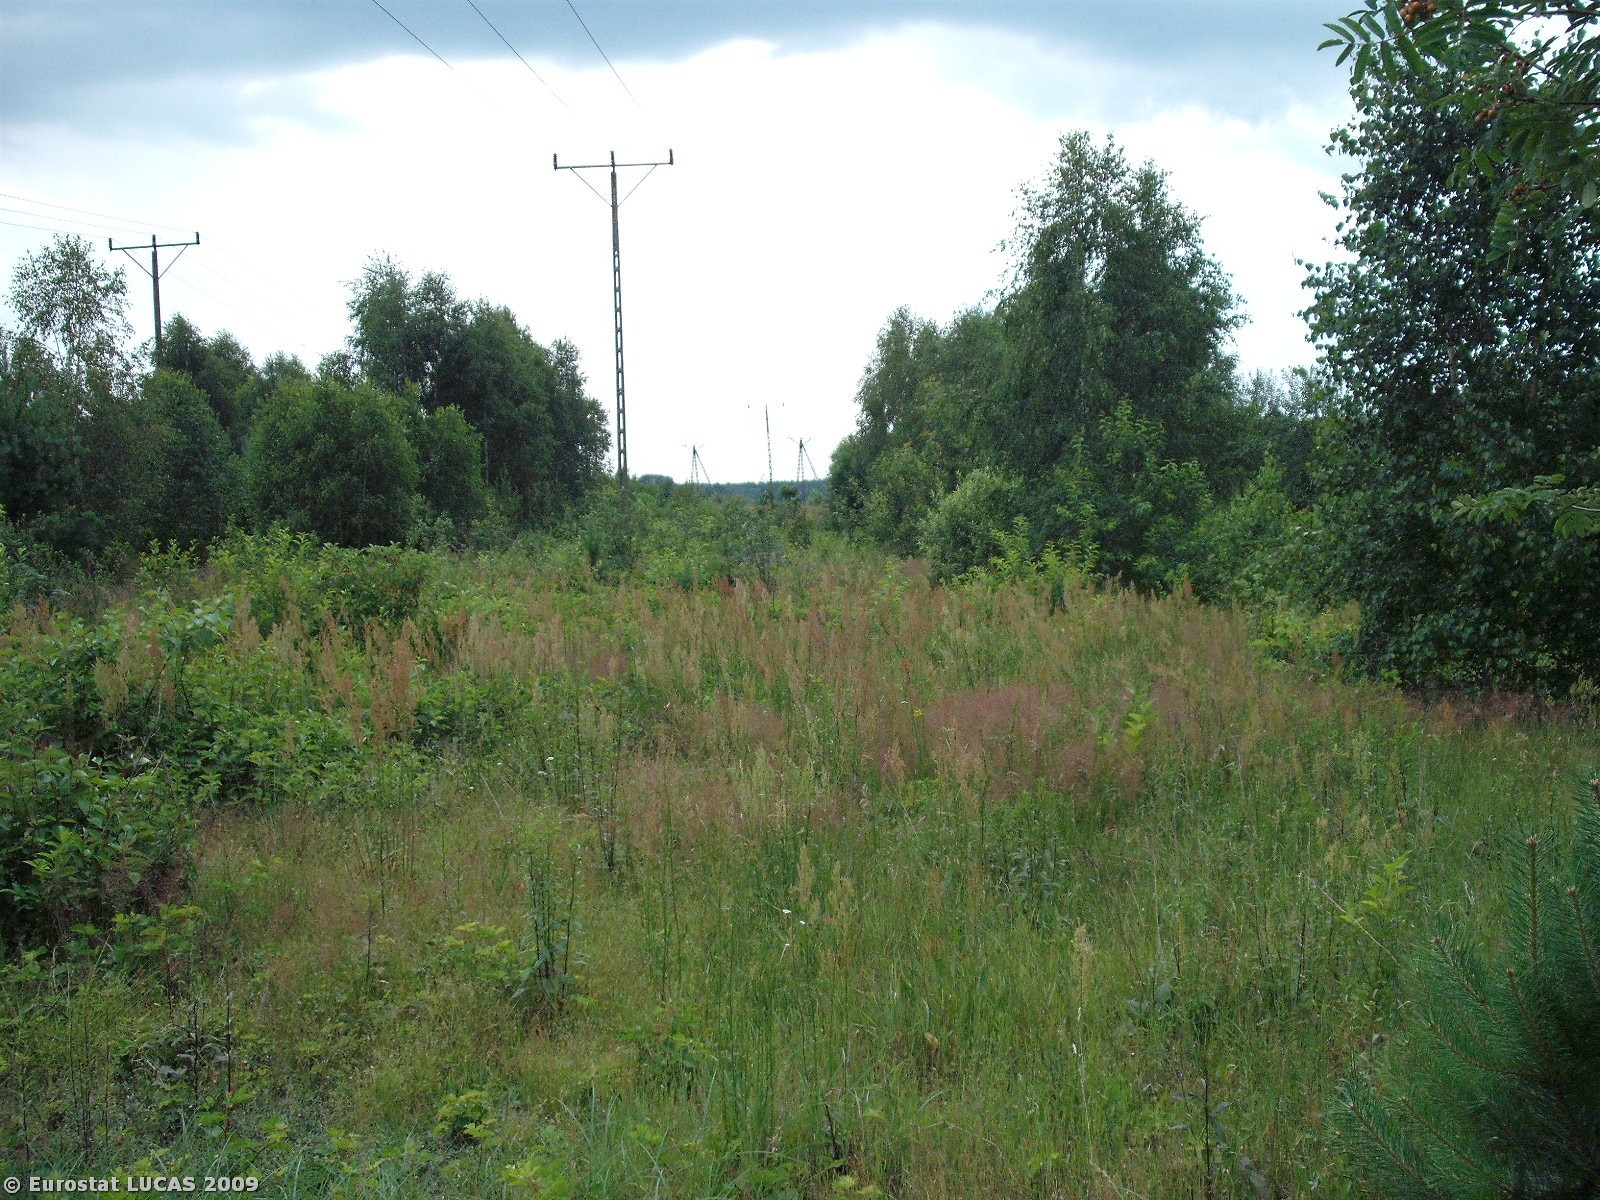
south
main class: Grassland
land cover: Spontaneously vegetated surfaces
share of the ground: > 75 %
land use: Unused
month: July
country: PL
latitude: 51.6331
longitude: 20.9519
